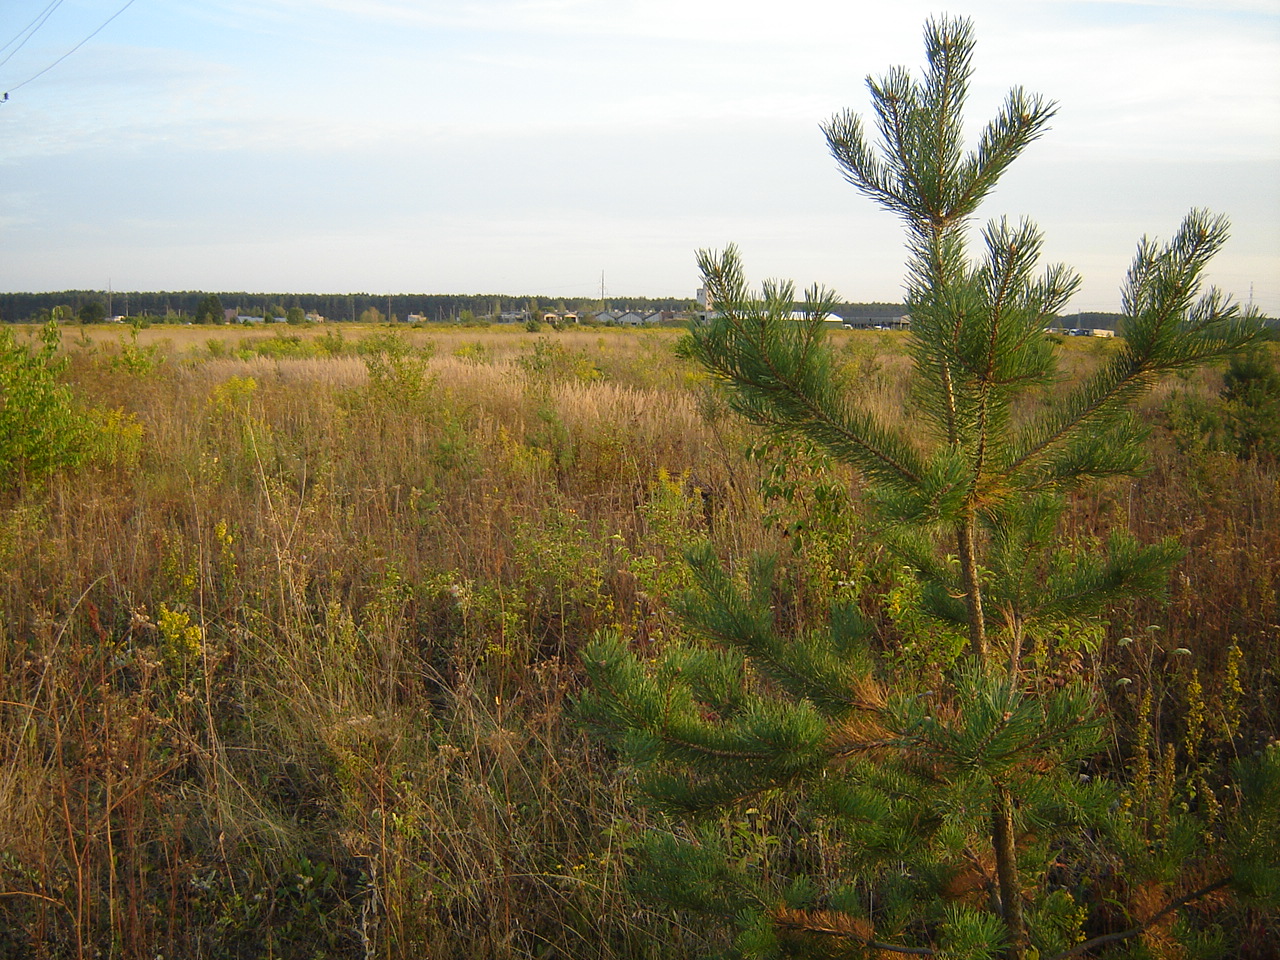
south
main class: Woodland
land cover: Pine dominated mixed woodland
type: hemiboreal forest and nemoral coniferous forest and mixed broadleaved-coniferous forest
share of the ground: 25 - 50 %
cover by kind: herbaceous plants 60 %, coniferous forest trees 25 %, broadleaved forest trees 15 %
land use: Forestry
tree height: < 5 m
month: August
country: LT
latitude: 54.5774
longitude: 25.2035
